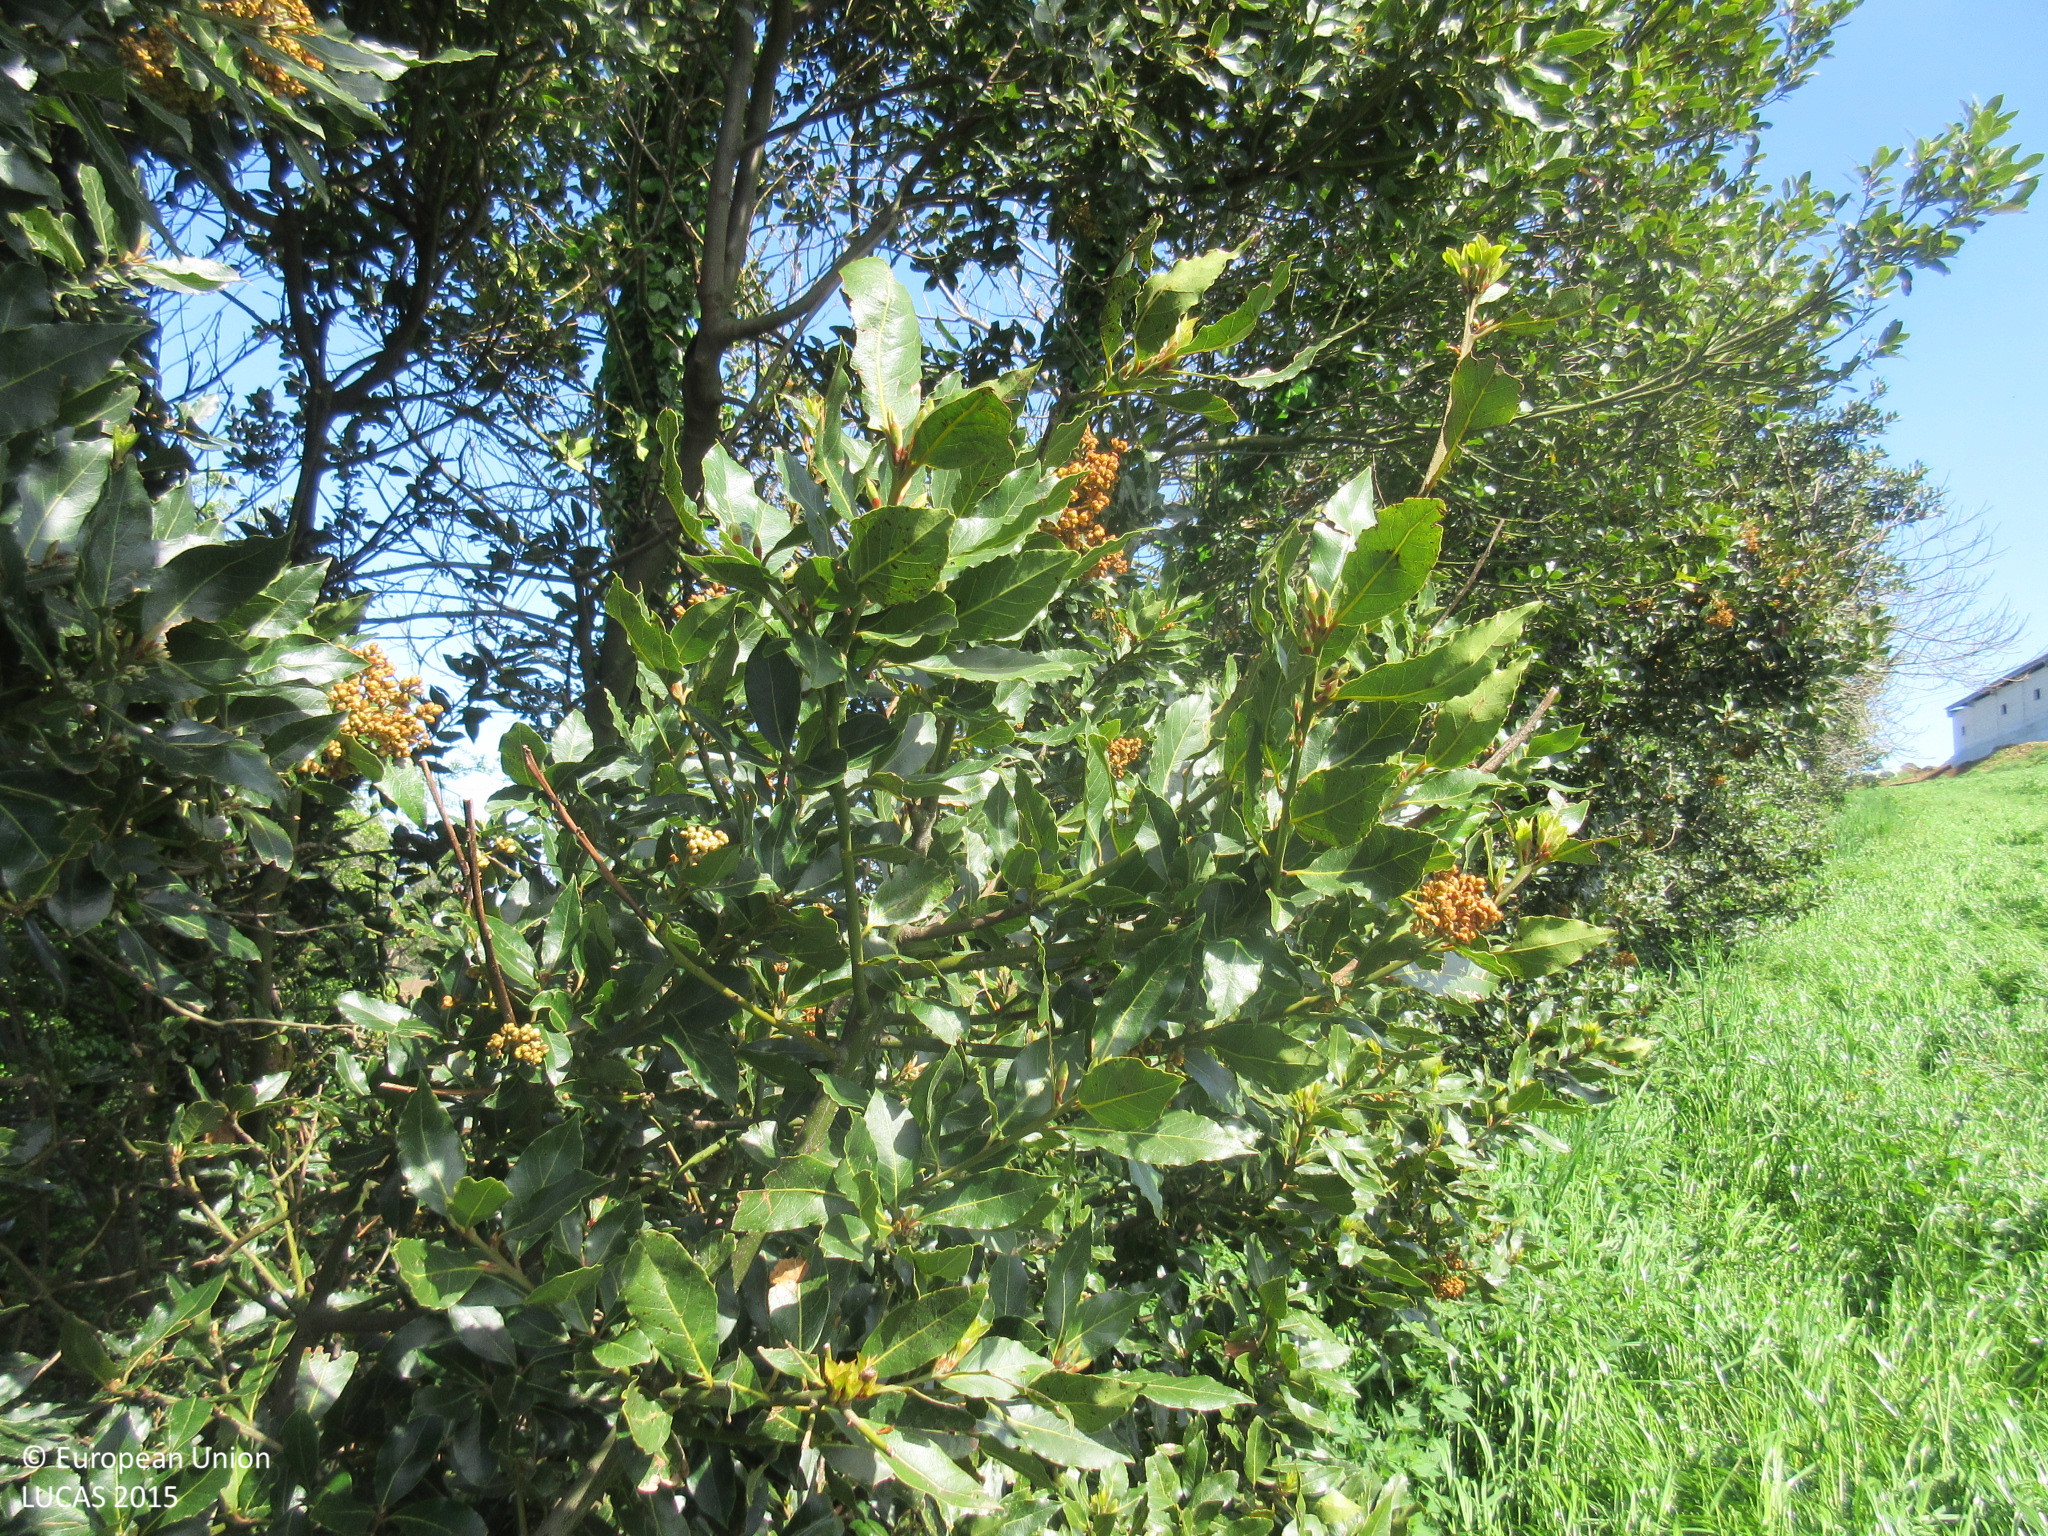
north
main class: Cropland
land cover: Temporary grasslands
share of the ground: > 75 %
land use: Agriculture (excluding fallow land and kitchen gardens)
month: April
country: ES
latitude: 43.4921
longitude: -6.9712
